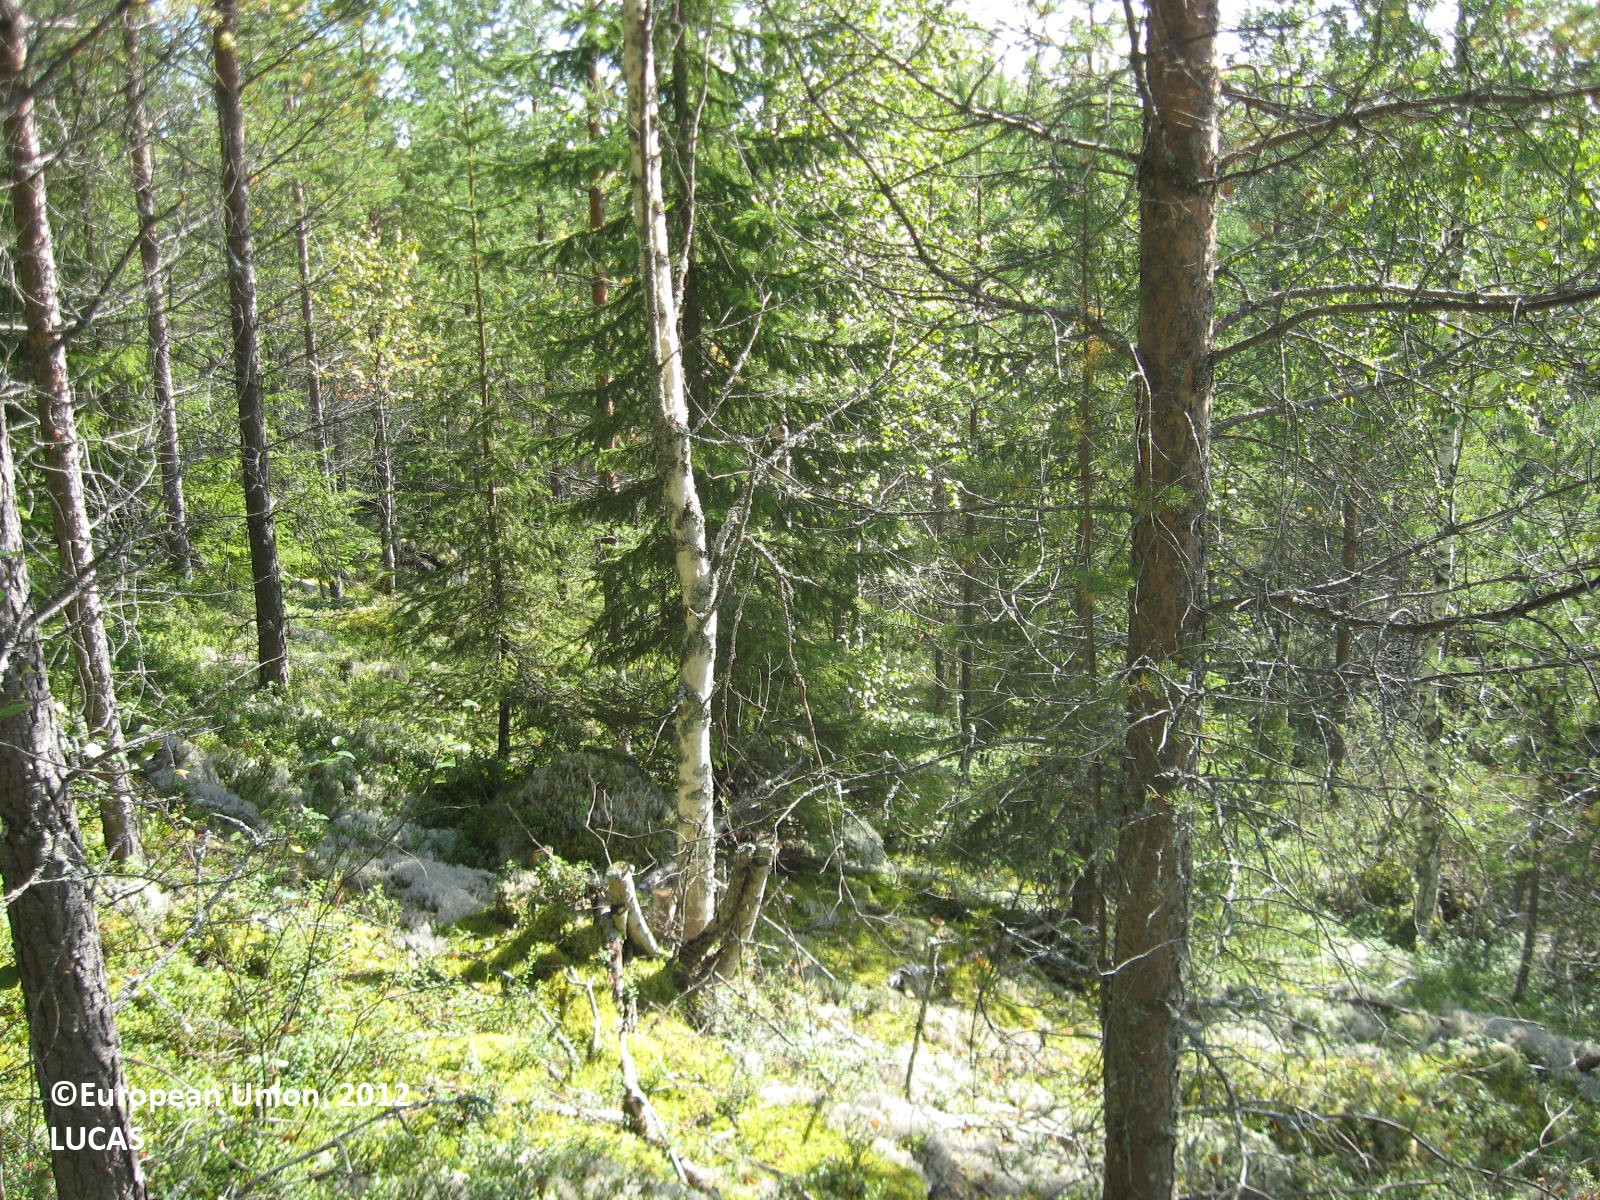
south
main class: Woodland
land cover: Pine dominated coniferous woodland
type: boreal forest
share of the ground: > 75 %
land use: Forestry
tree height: > 5 m
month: August
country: FI
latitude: 63.6798
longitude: 29.7420
